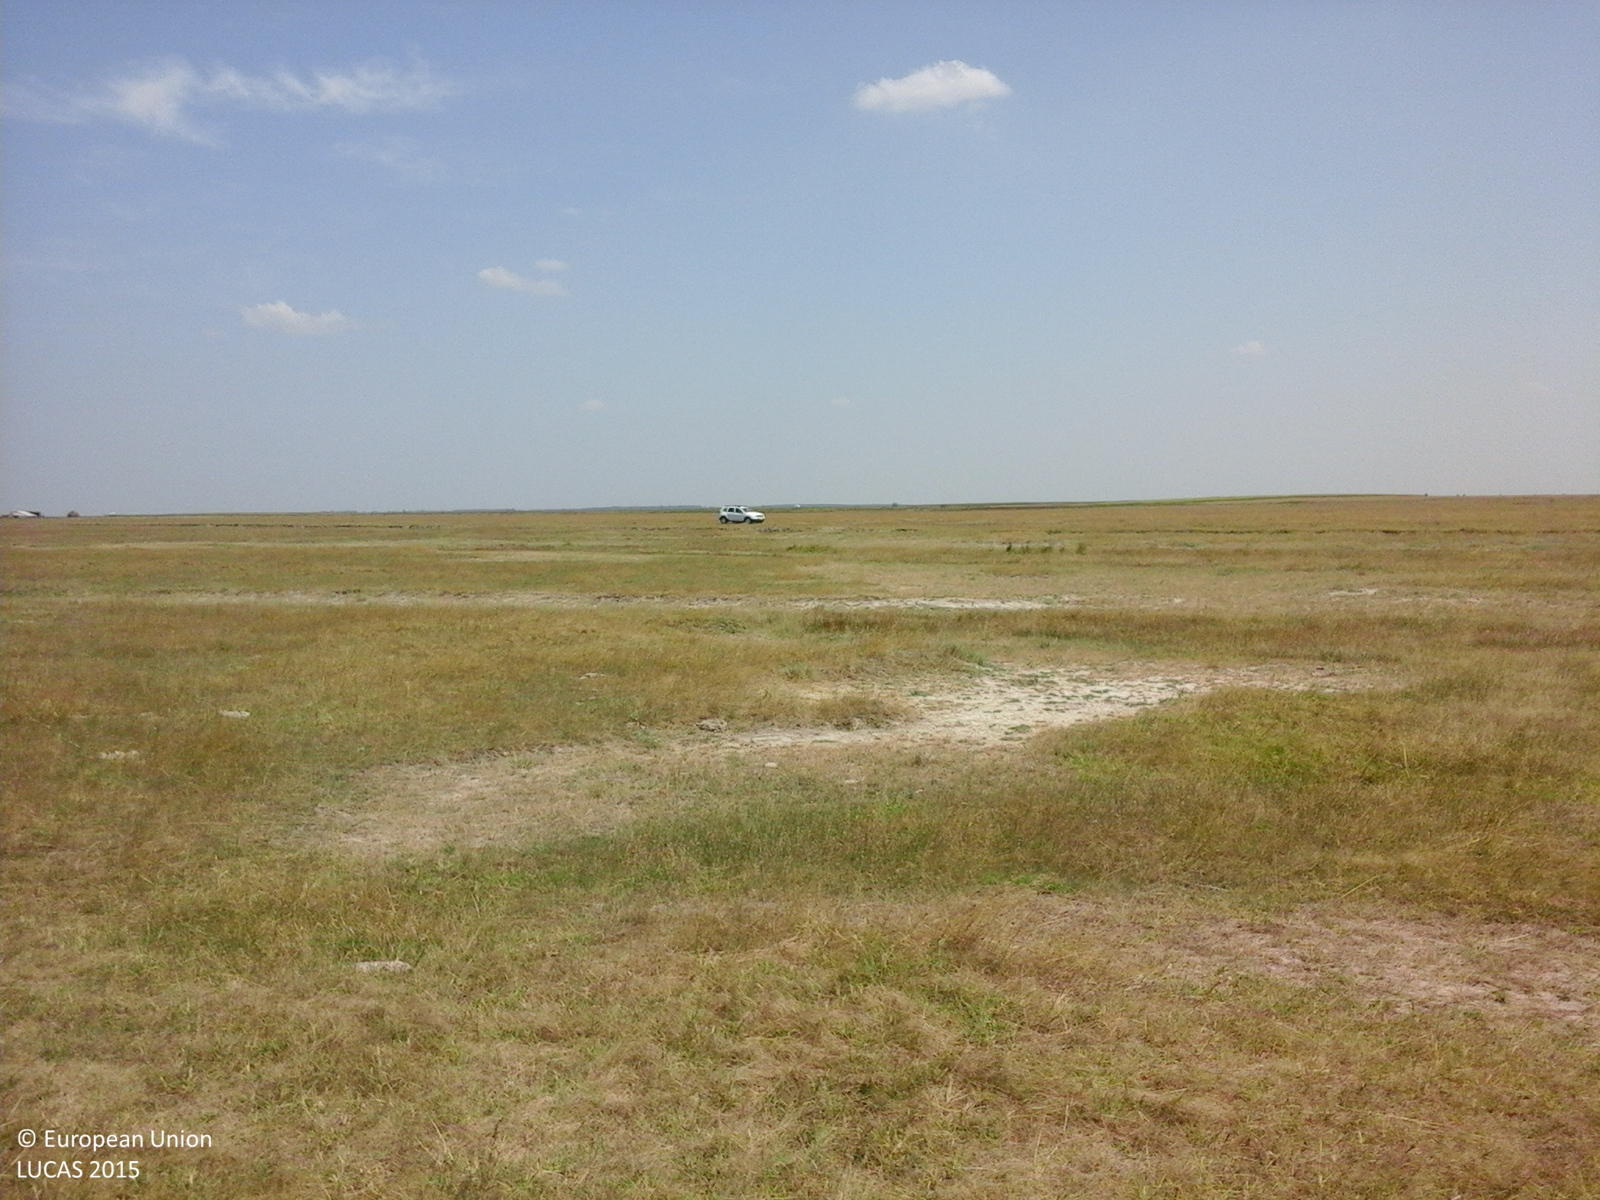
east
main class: Grassland
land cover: Grassland without tree/shrub cover
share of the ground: > 75 %
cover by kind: herbaceous plants 100 %
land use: Agriculture (excluding fallow land and kitchen gardens)
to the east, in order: Grassland without tree/shrub cover; Ditches and canals; Grassland without tree/shrub cover
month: August
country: RO
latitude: 45.0106
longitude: 26.6838
